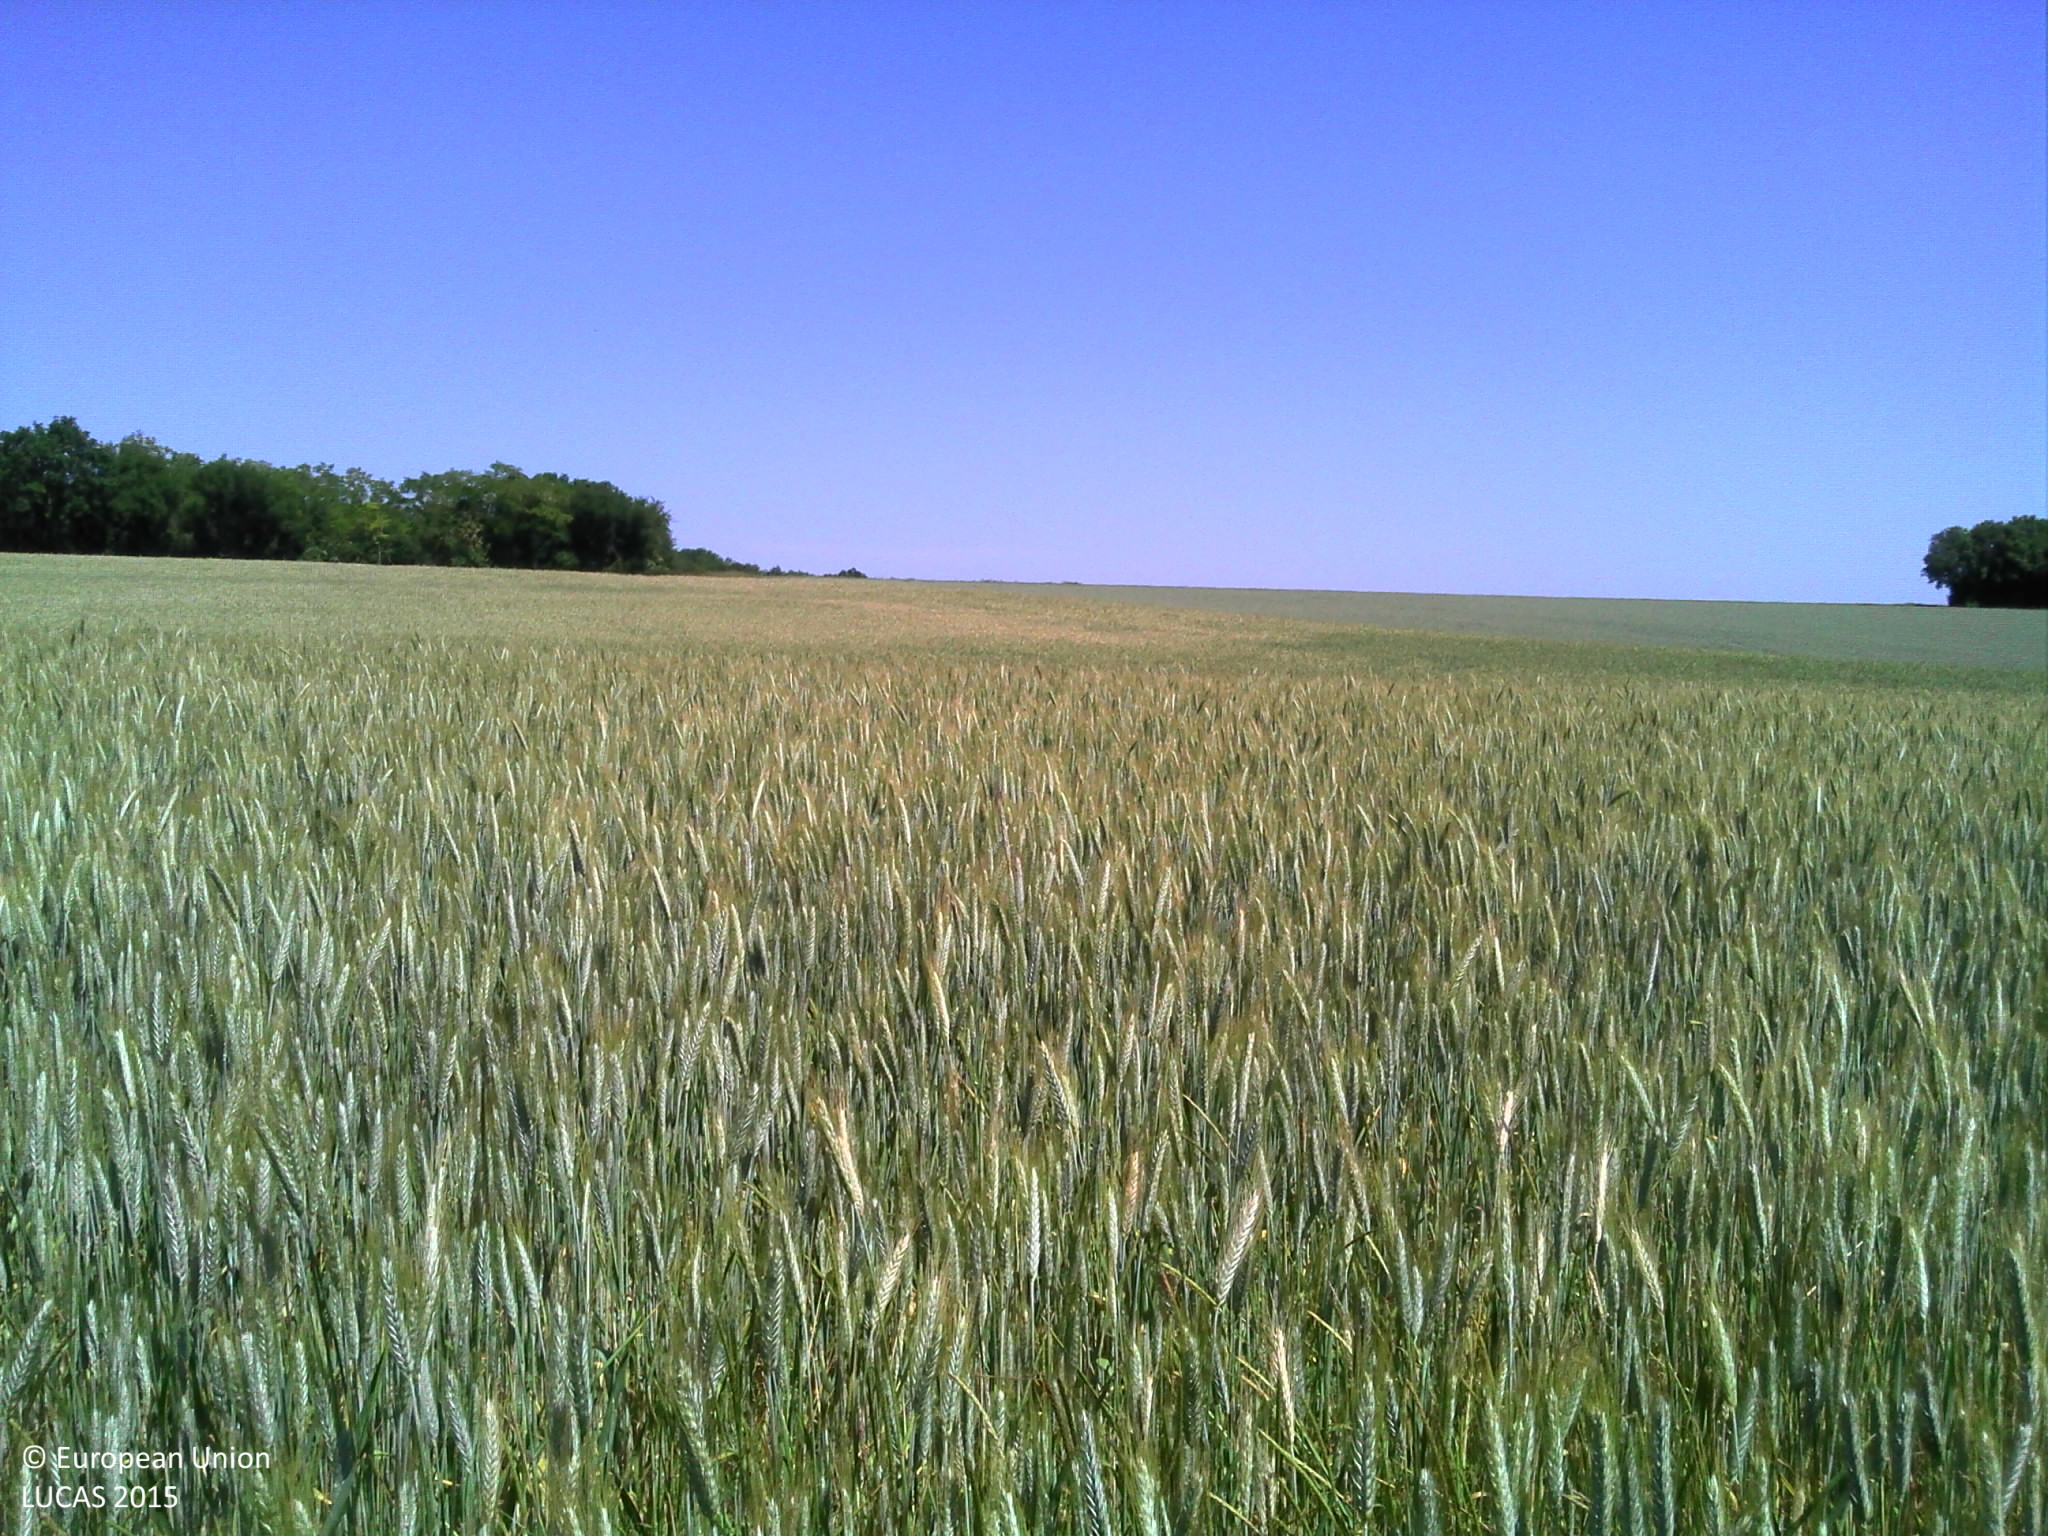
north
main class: Cropland
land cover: Triticale
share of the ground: > 75 %
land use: Agriculture (excluding fallow land and kitchen gardens)
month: June
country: FR
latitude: 47.5880
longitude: 3.9471
